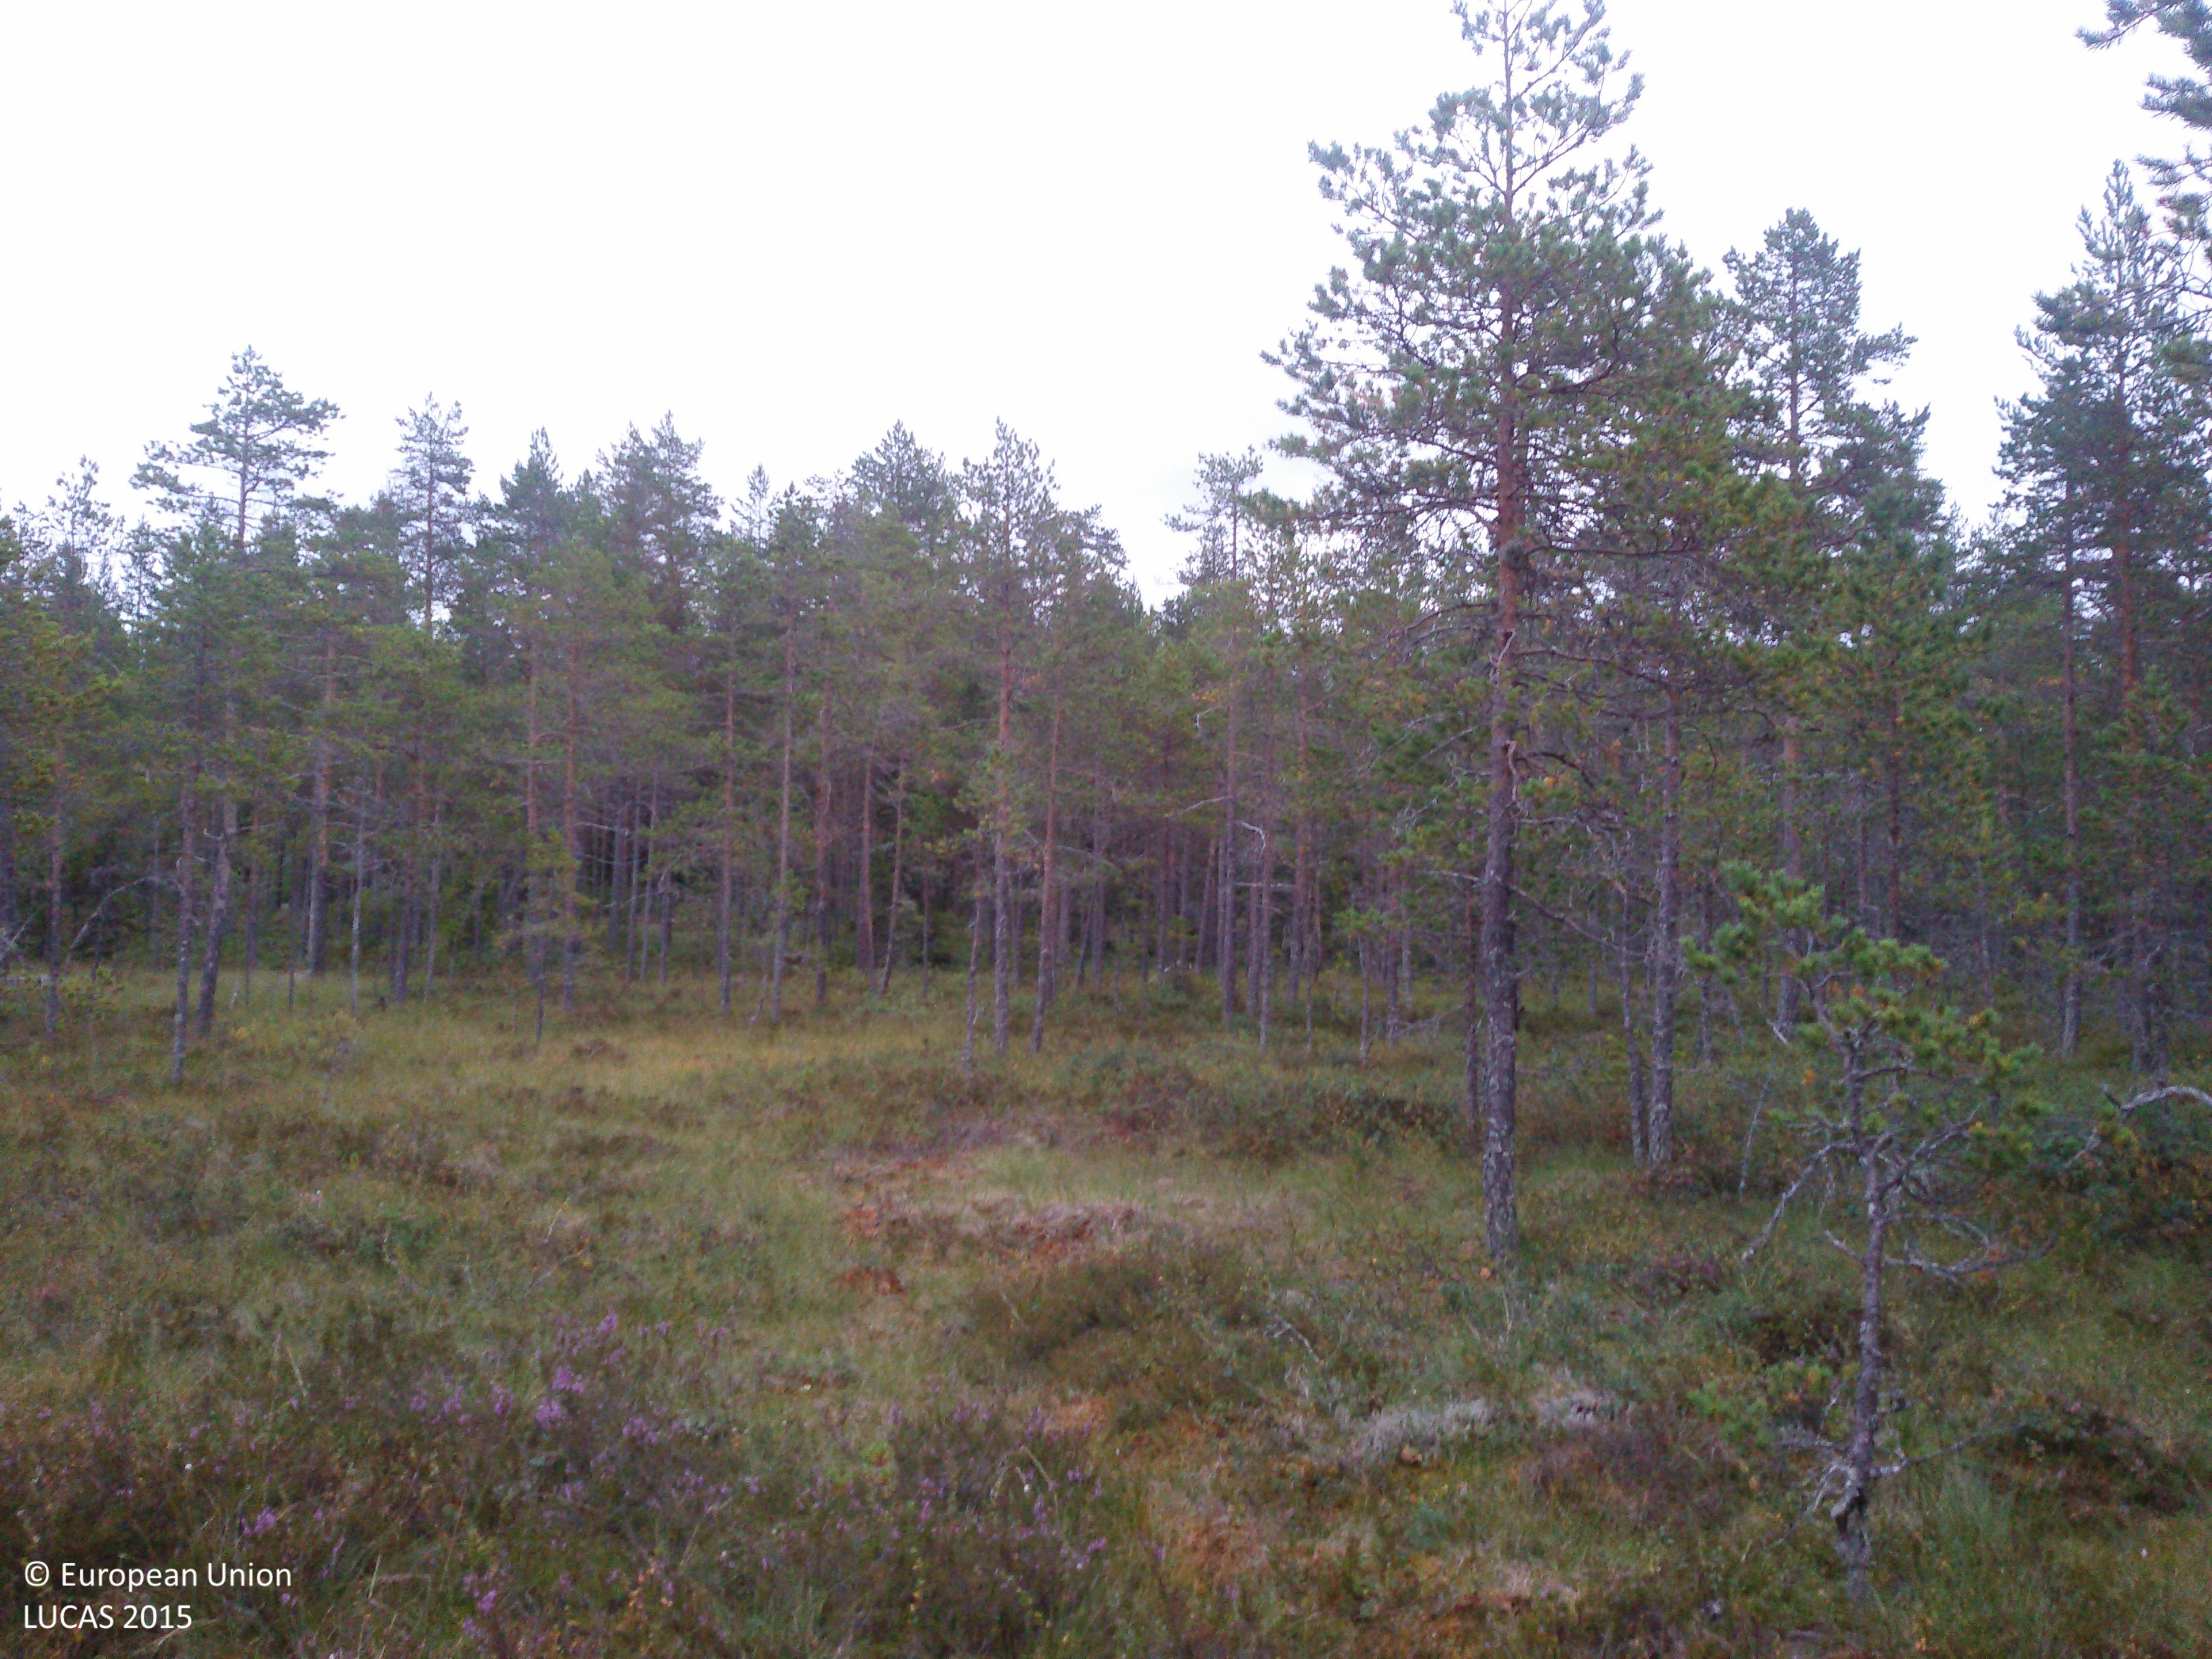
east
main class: Woodland
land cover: Pine dominated coniferous woodland
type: boreal forest
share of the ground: 50 - 75 %
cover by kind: coniferous forest trees 50 %, herbaceous plants 25 %, lichens and mosses 25 %
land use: Forestry
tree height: > 5 m
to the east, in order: Pine dominated coniferous woodland; Grassland without tree/shrub cover; Paved roads, cycling and walking lanes; Ditches and canals; Pine dominated coniferous woodland
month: September
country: SE
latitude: 60.8377
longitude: 15.3401
